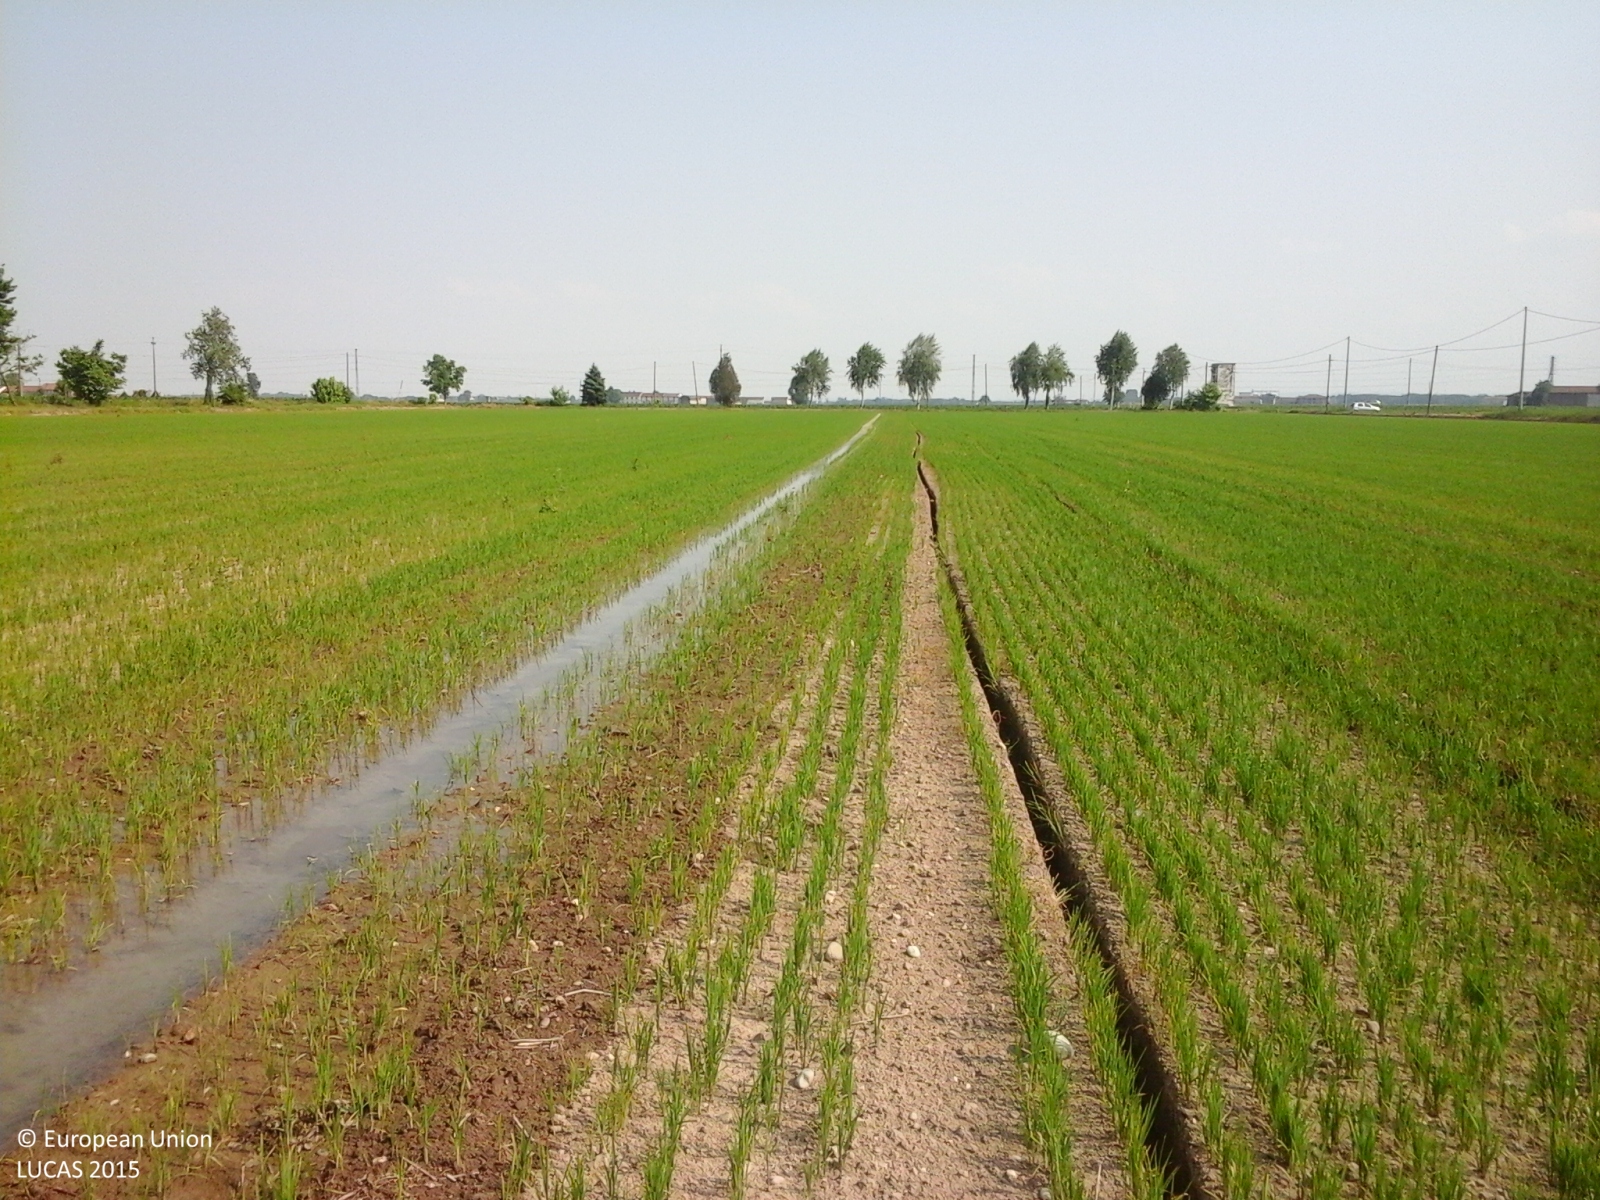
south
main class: Cropland
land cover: Rice
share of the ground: 25 - 50 %
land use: Agriculture (excluding fallow land and kitchen gardens)
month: May
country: IT
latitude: 45.3809
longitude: 8.2023
